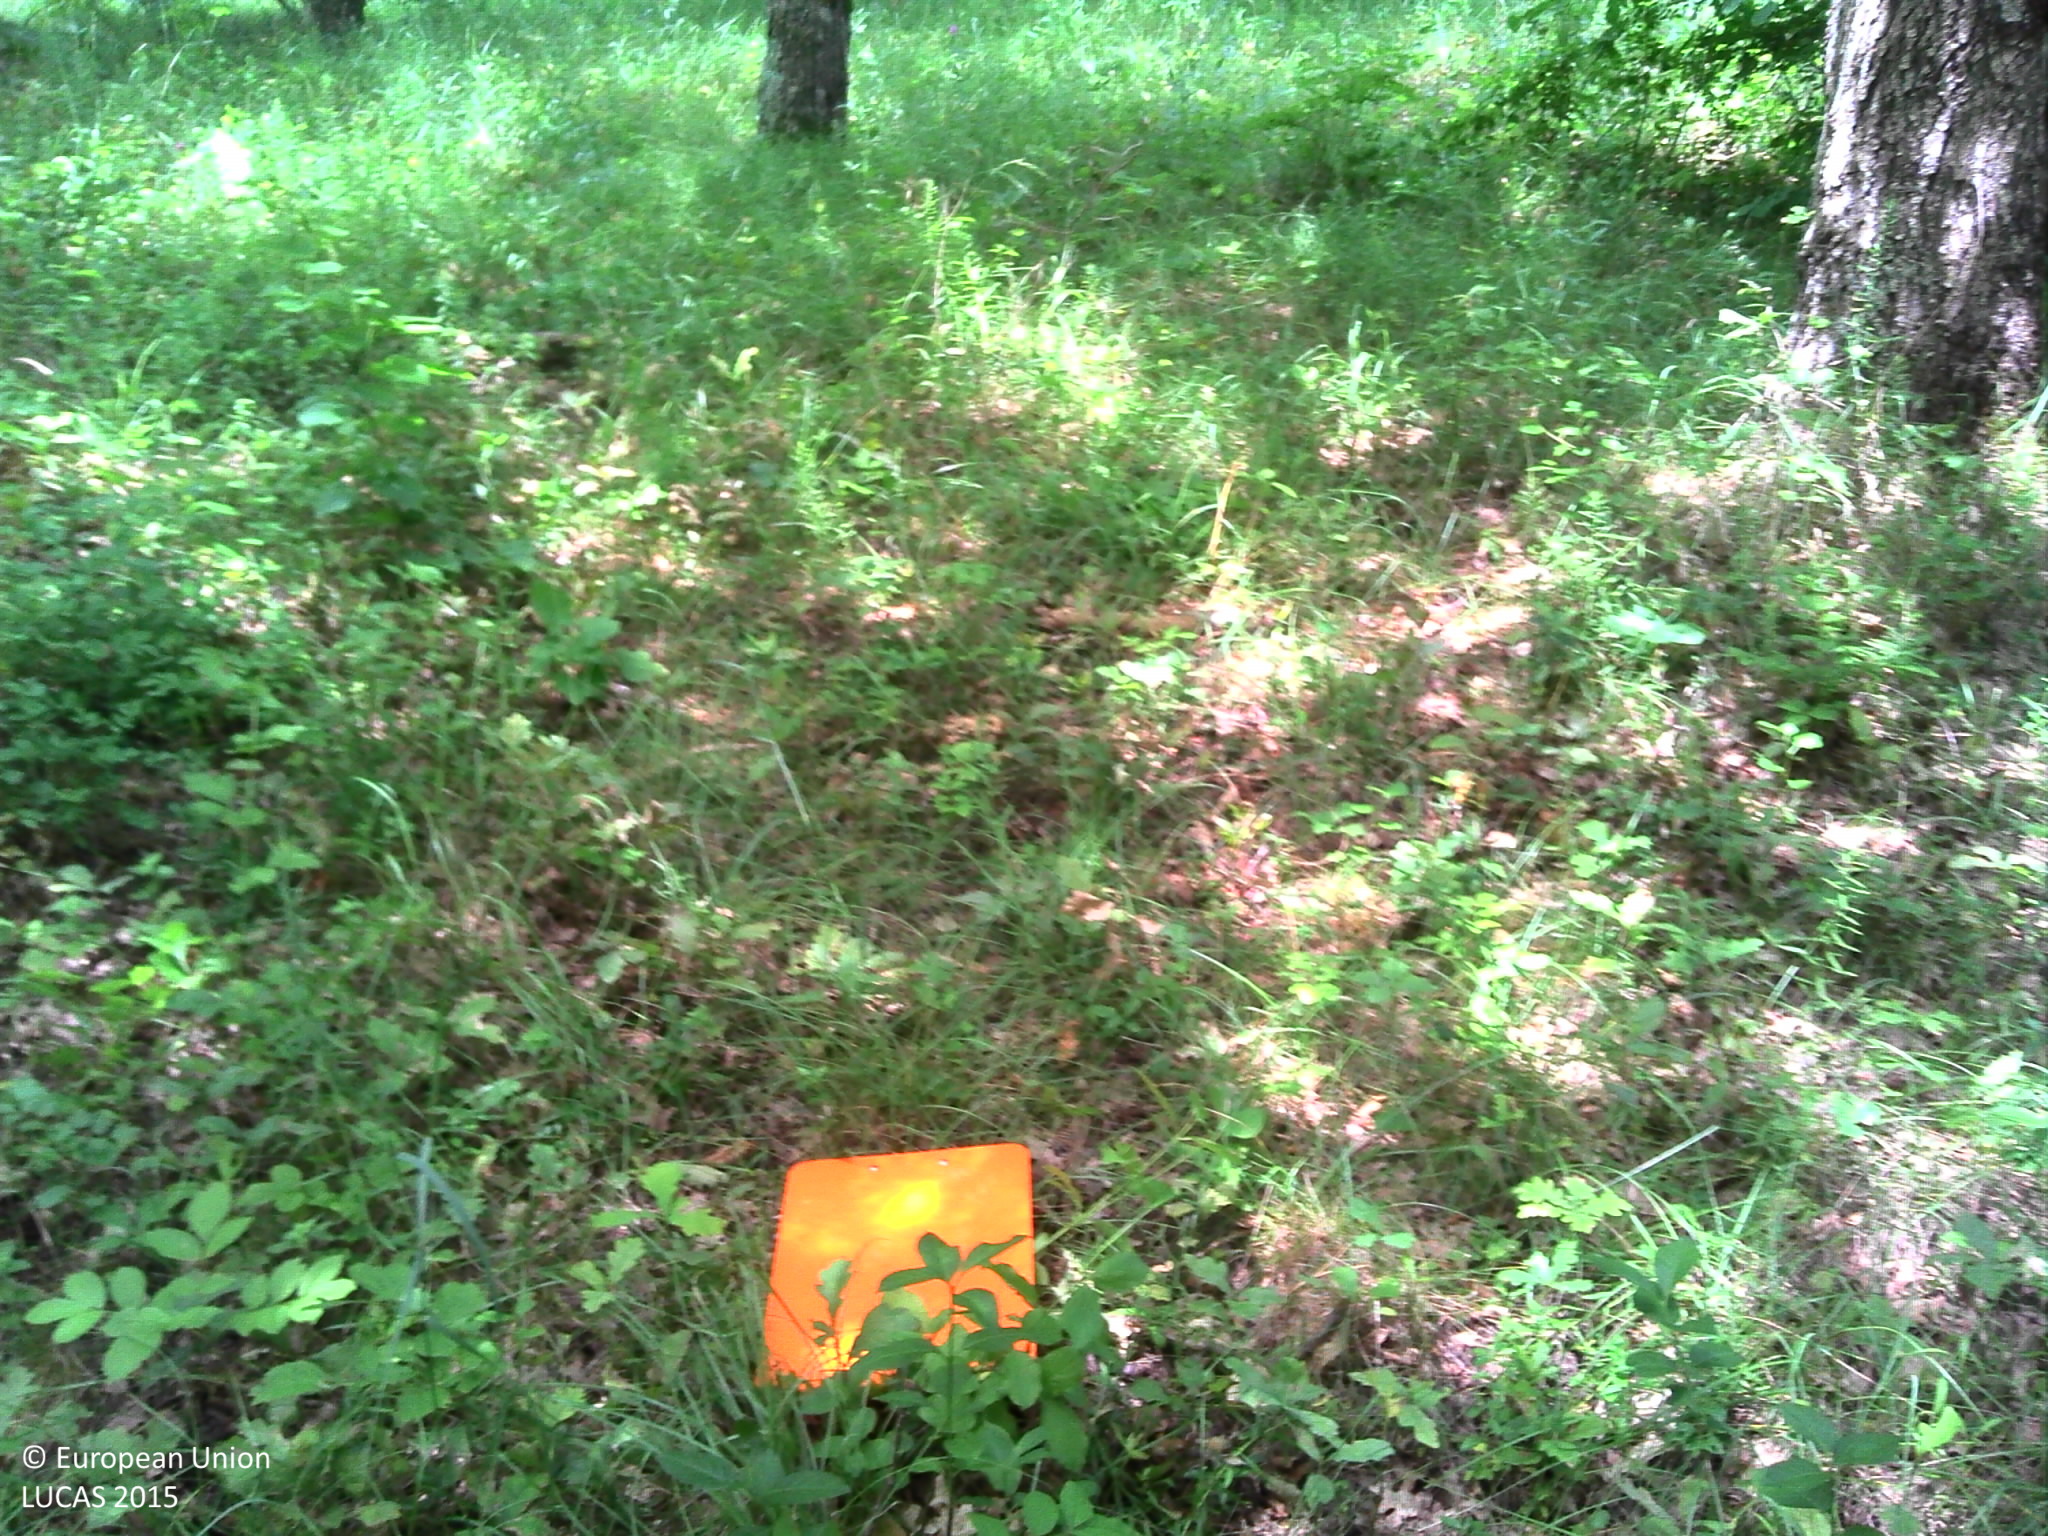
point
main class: Woodland
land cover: Broadleaved woodland
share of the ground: > 75 %
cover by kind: broadleaved forest trees 100 %
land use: Forestry
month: June
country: FR
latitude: 44.6492
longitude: 5.0764
